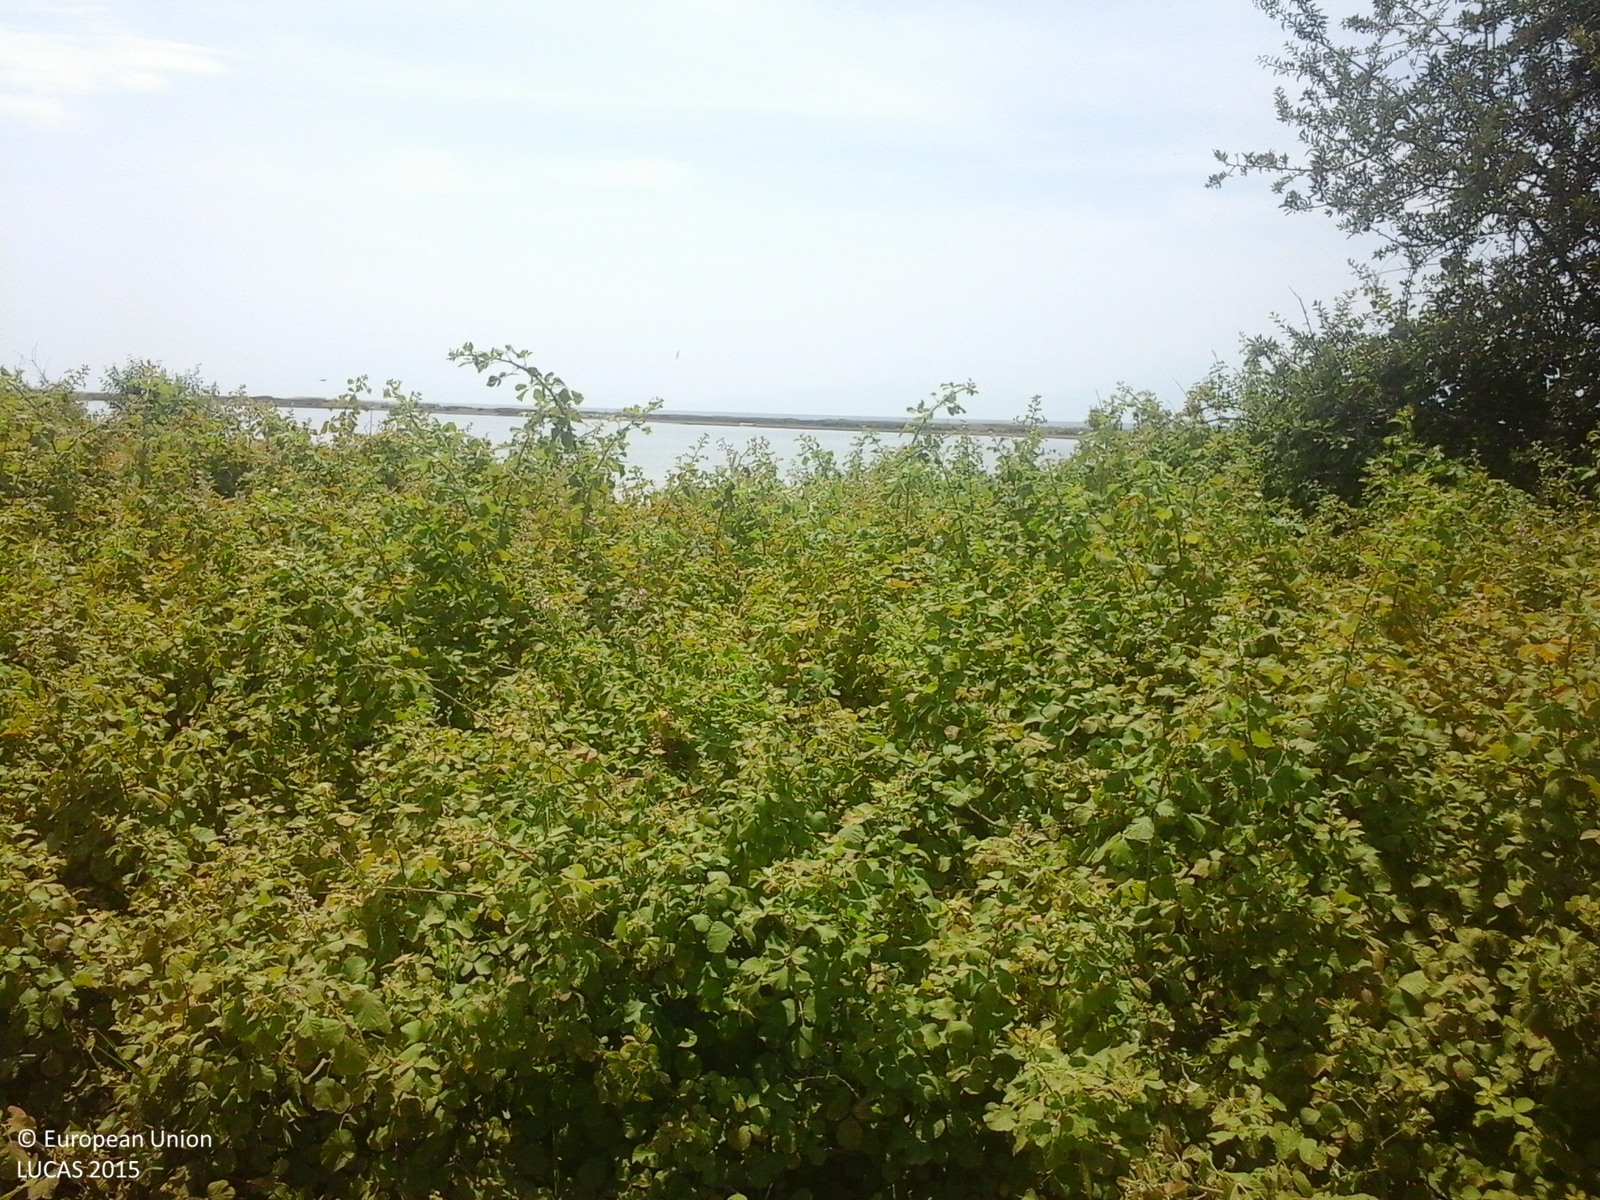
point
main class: Shrubland
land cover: Shrubland with sparse tree cover
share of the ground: > 75 %
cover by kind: shrubs 95 %, broadleaved forest trees 5 %
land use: Semi-natural and natural areas not in use
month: June
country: GR
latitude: 40.4407
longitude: 22.8662
